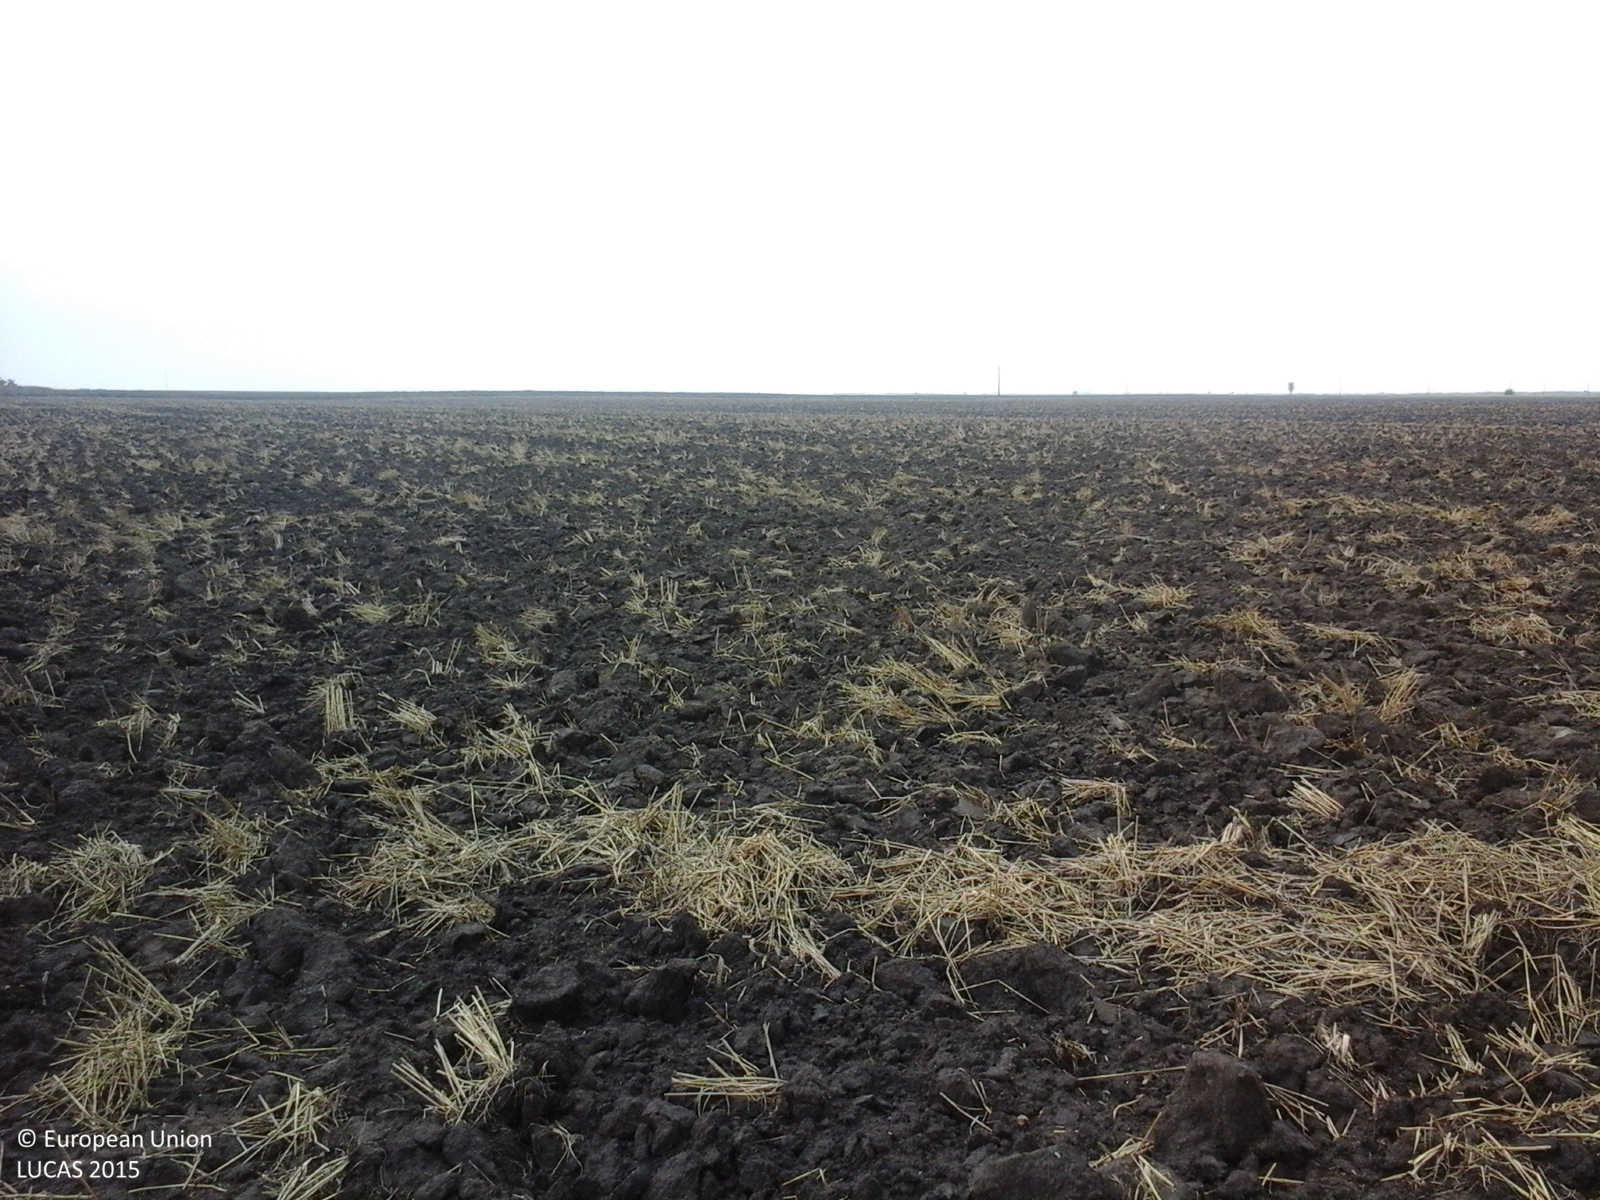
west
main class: Cropland
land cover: Common wheat
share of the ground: < 10 %
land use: Agriculture (excluding fallow land and kitchen gardens)
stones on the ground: < 10 %
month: August
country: RO
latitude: 46.1520
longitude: 20.3951
